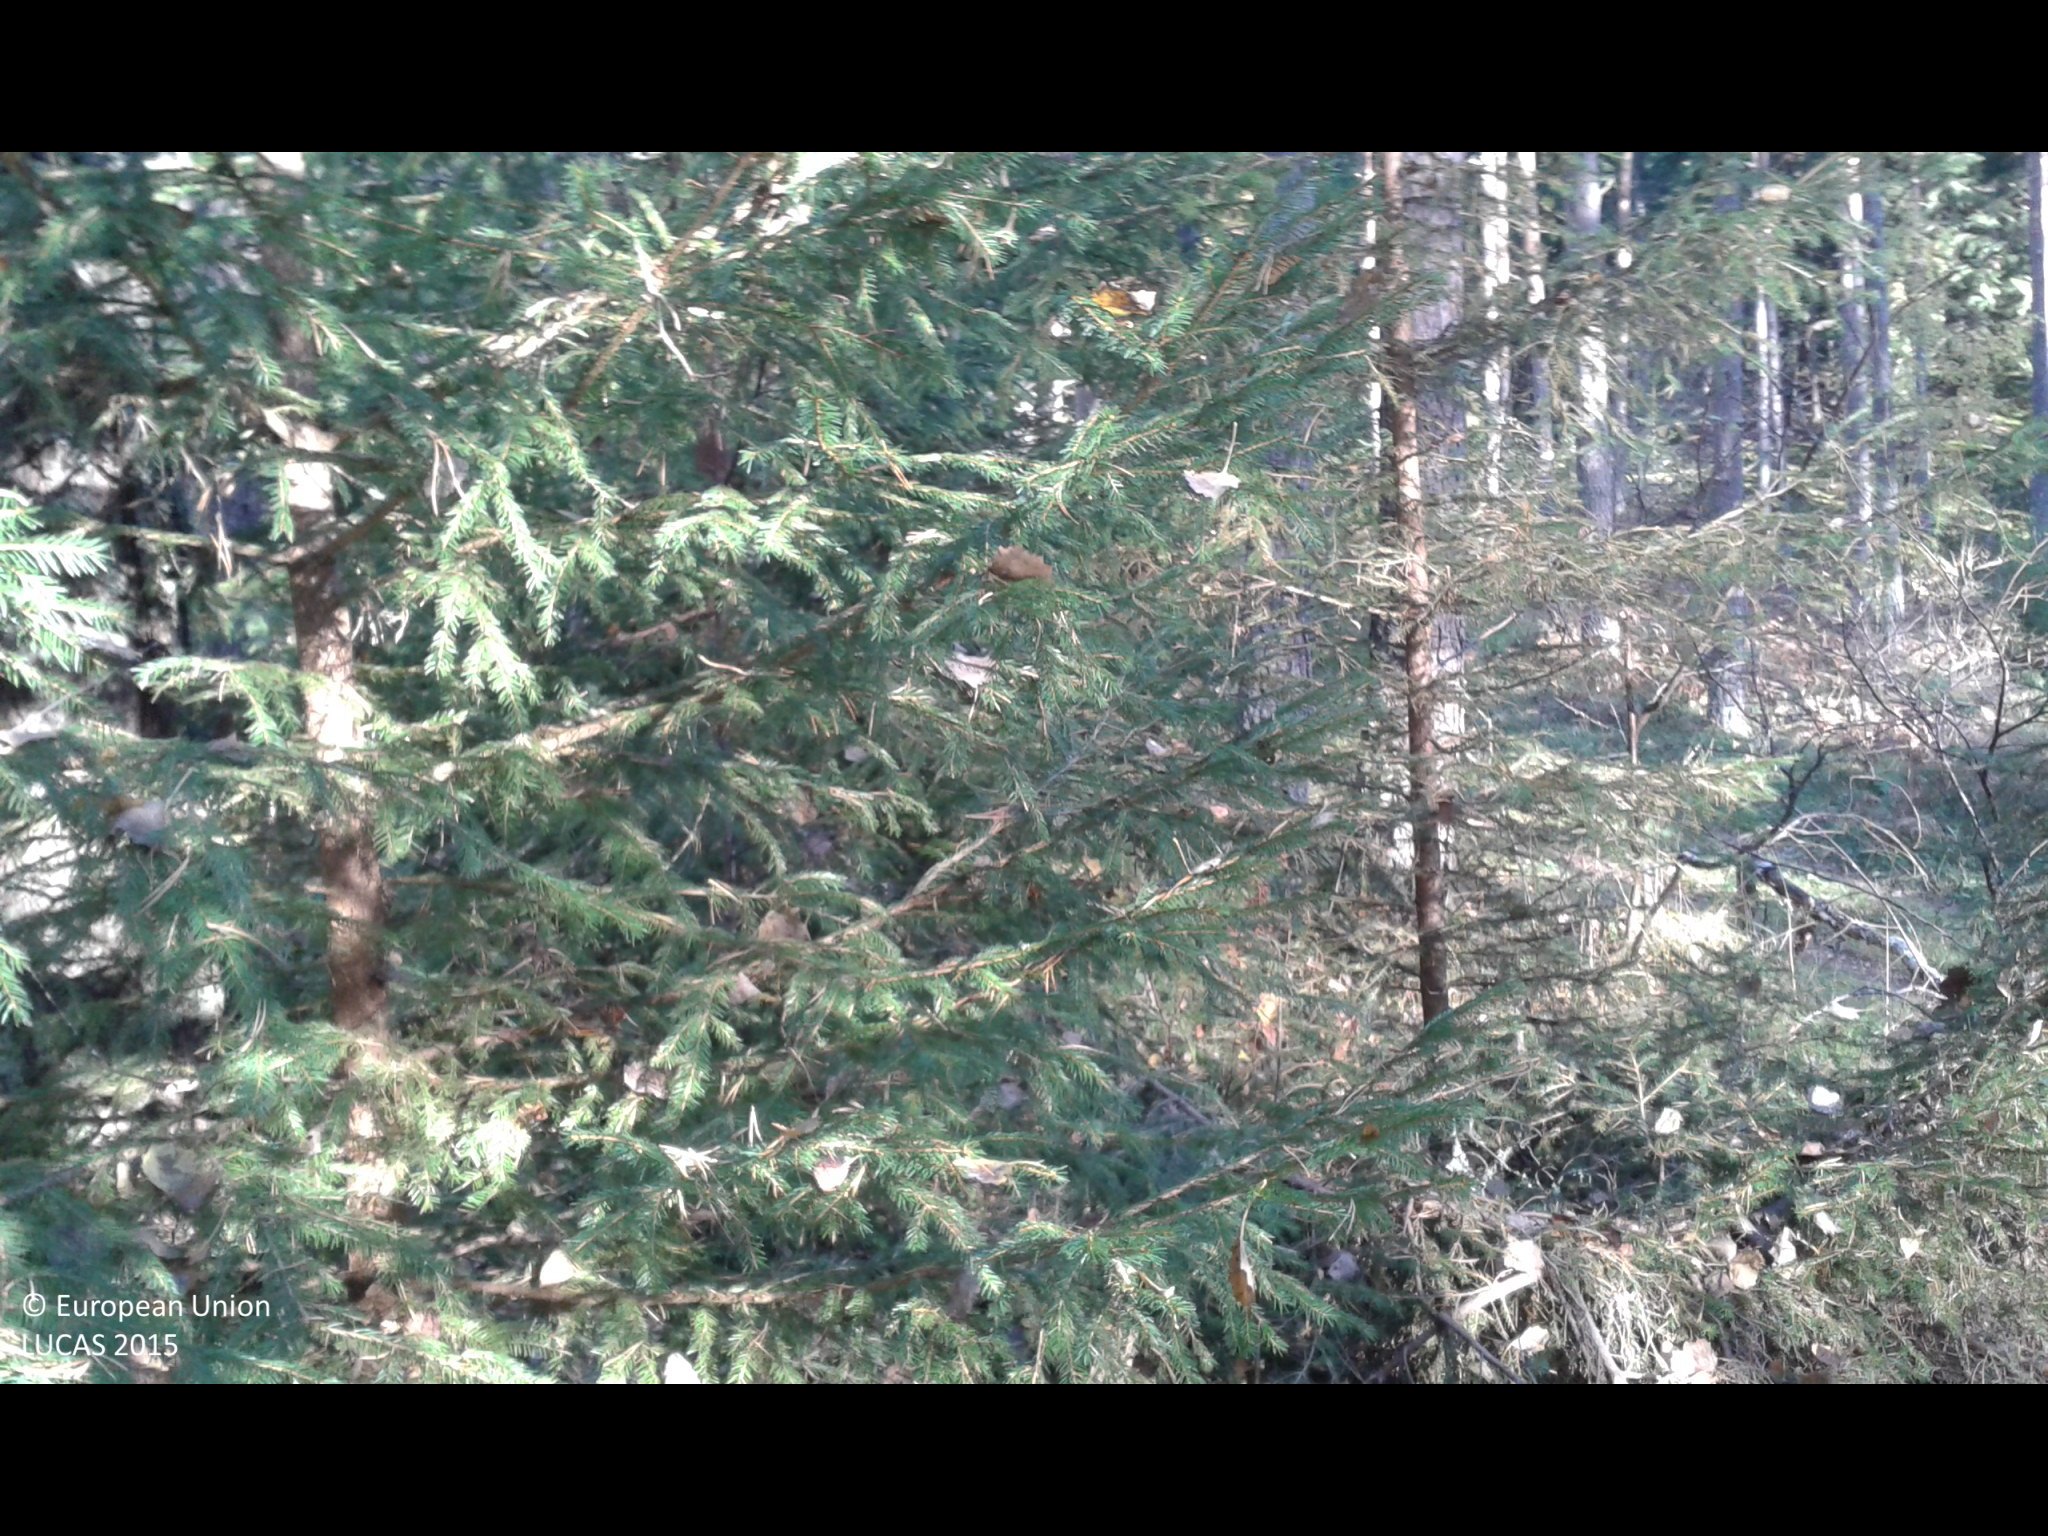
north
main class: Woodland
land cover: Pine dominated coniferous woodland
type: boreal forest
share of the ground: 50 - 75 %
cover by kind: coniferous forest trees 55 %, herbaceous plants 30 %, broadleaved forest trees 15 %
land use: Forestry
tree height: > 5 m
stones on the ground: < 10 %
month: October
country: SE
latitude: 58.8866
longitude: 17.3366
